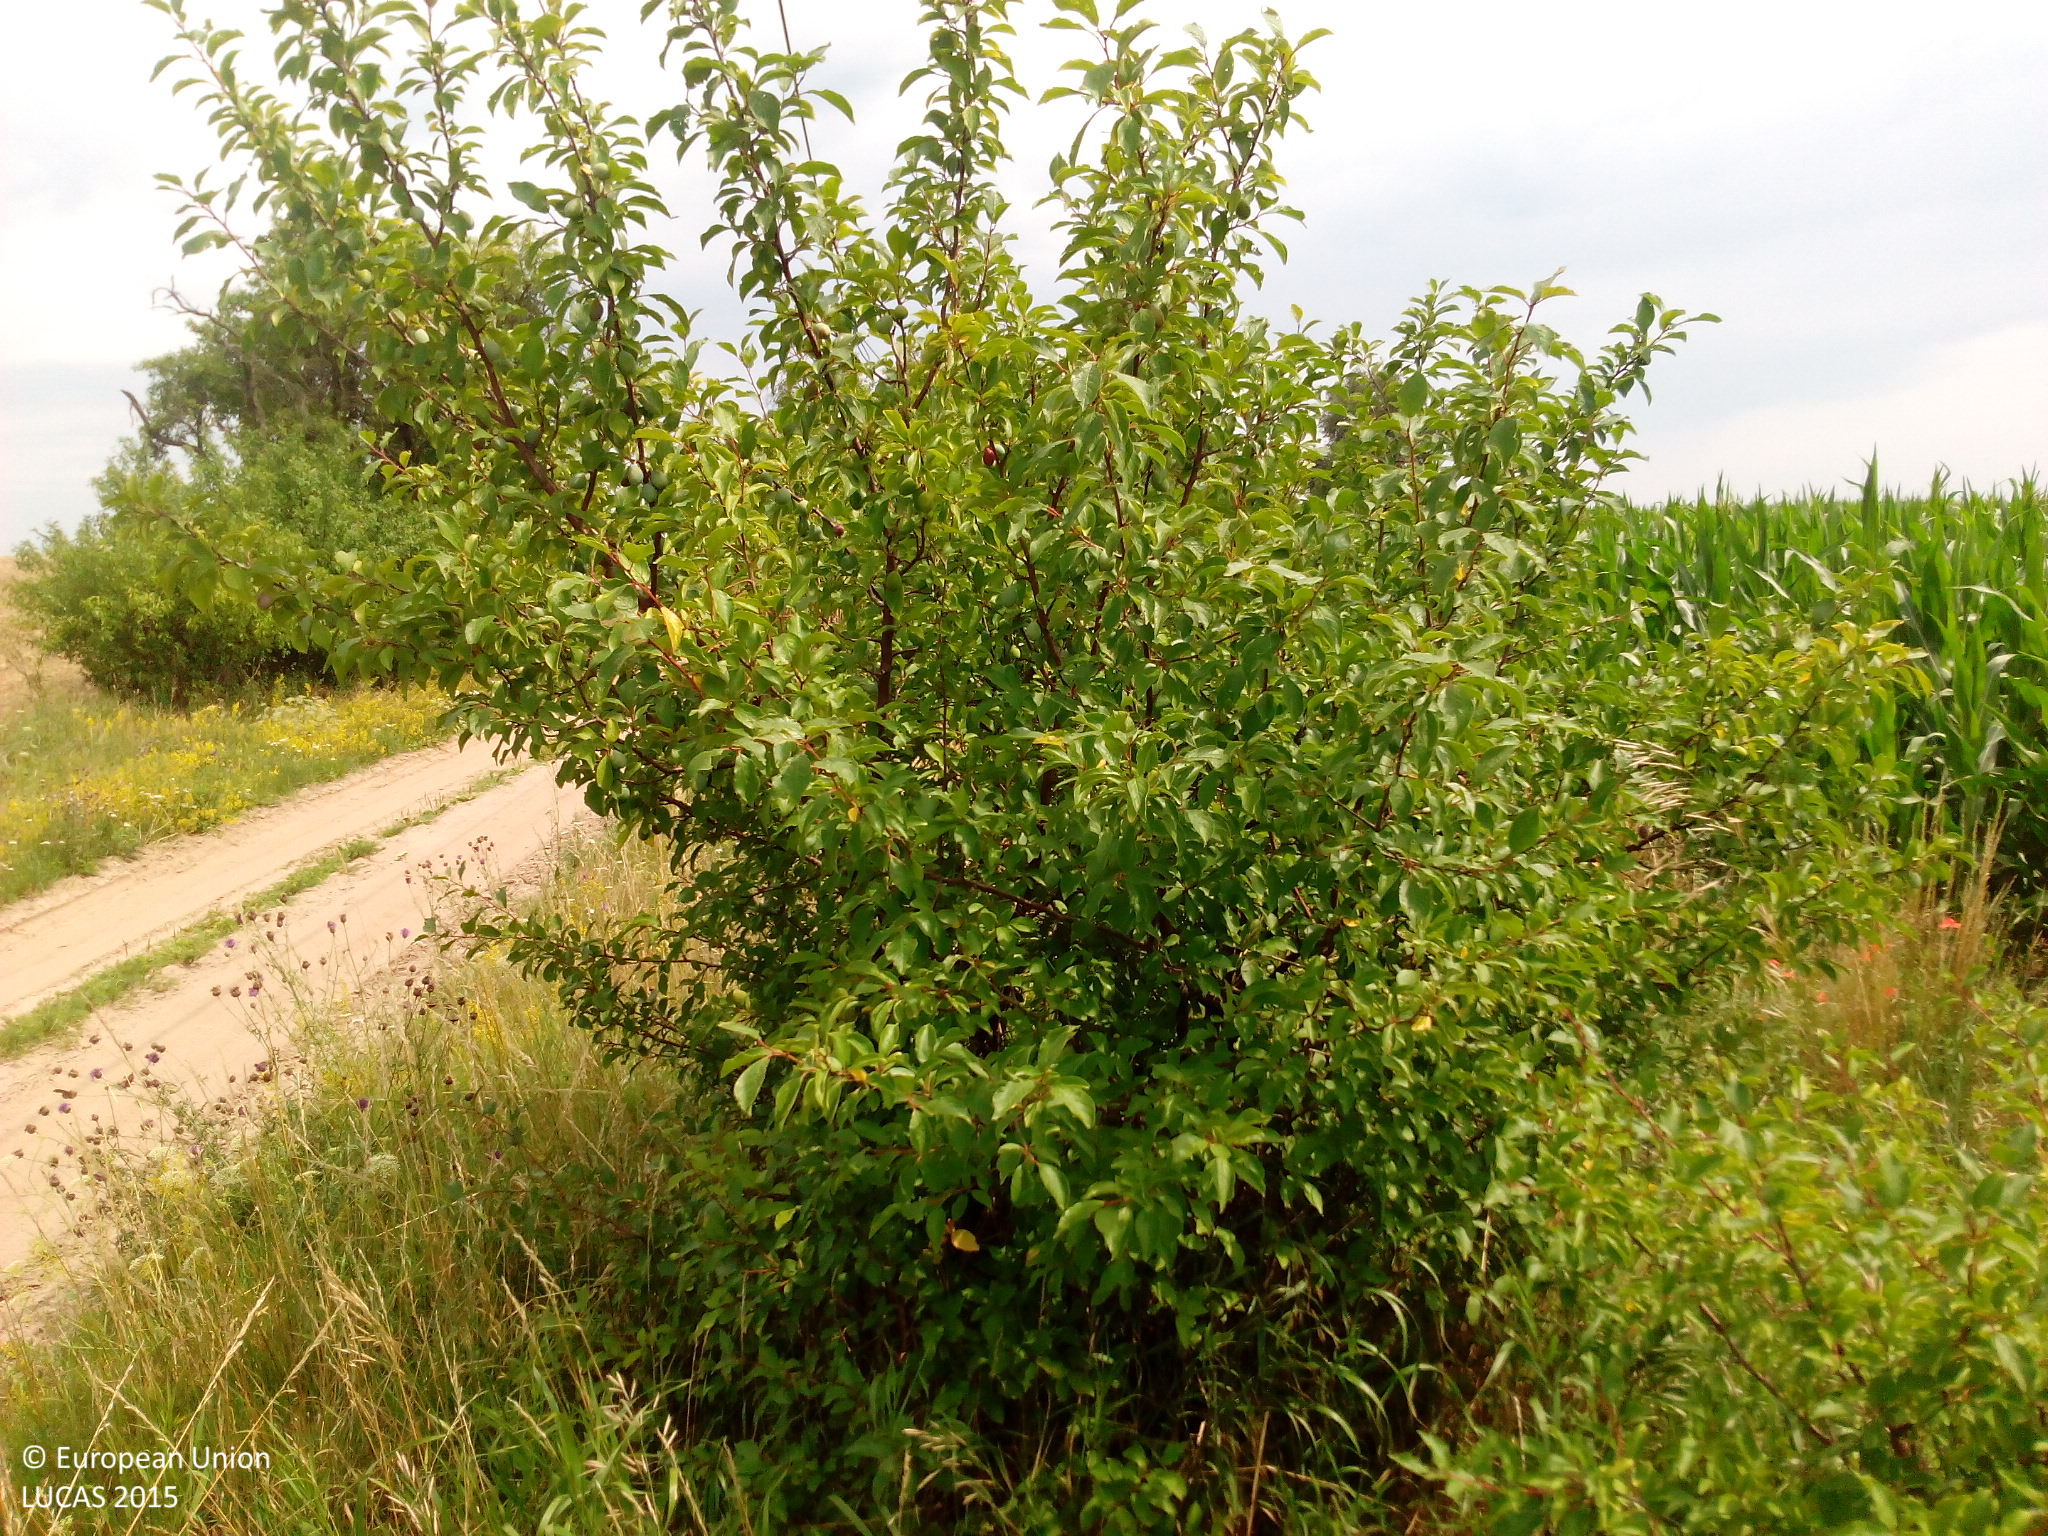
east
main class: Cropland
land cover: Maize
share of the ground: > 75 %
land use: Agriculture (excluding fallow land and kitchen gardens)
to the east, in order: Maize; Barley
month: July
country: DE
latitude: 52.4831
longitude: 12.1936
